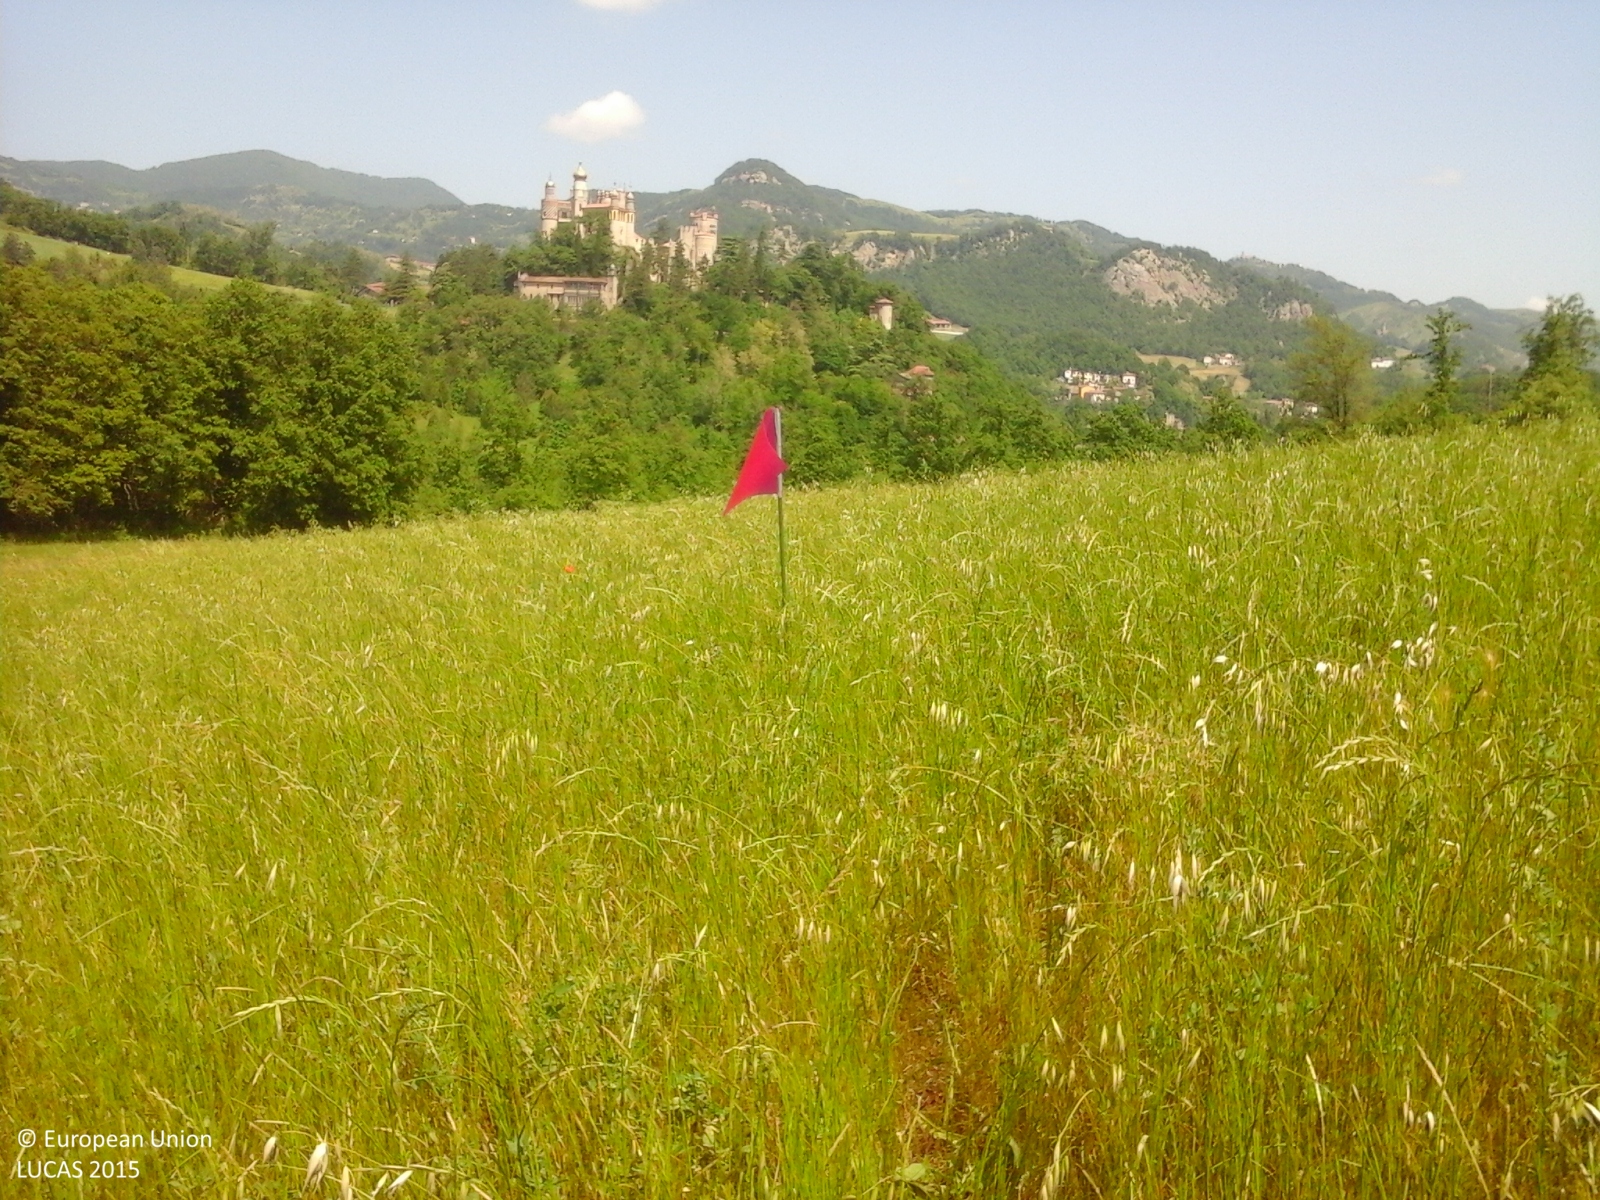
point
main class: Grassland
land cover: Grassland without tree/shrub cover
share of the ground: > 75 %
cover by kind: herbaceous plants 100 %
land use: Agriculture (excluding fallow land and kitchen gardens)
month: May
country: IT
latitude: 44.2189
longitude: 11.0614
